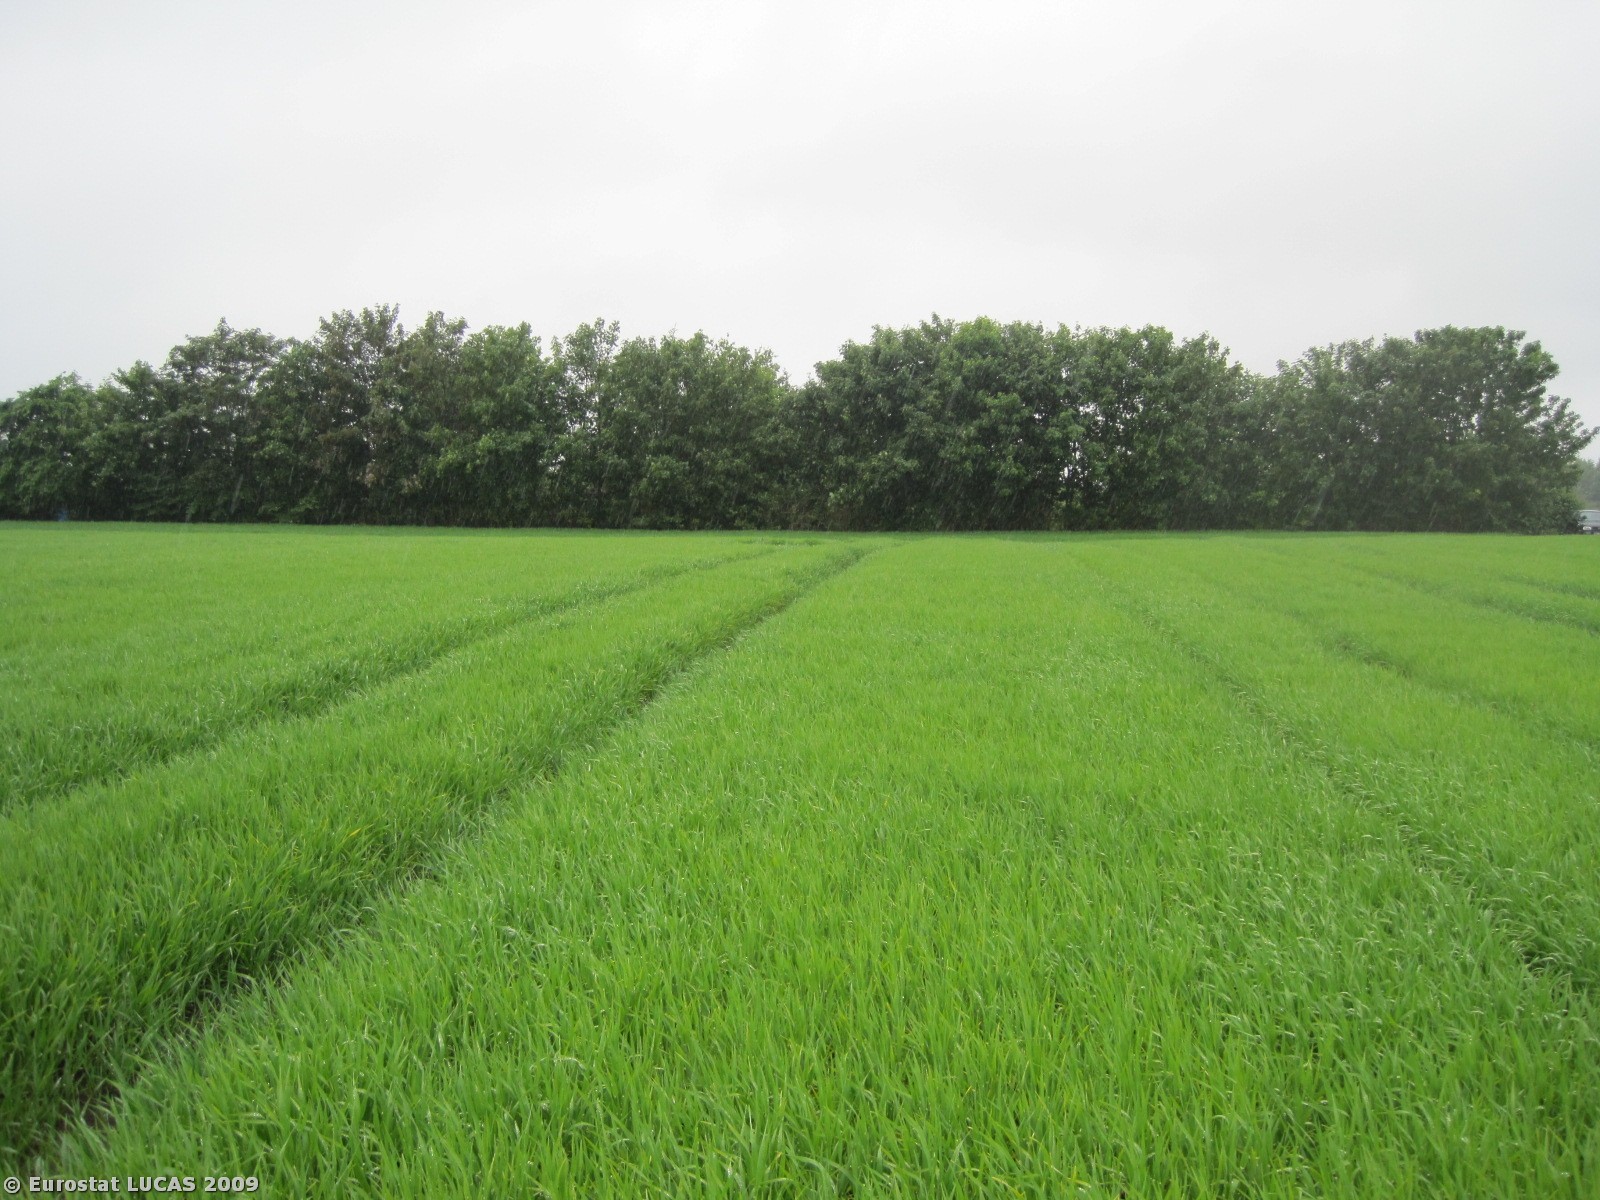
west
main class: Cropland
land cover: Barley
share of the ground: > 75 %
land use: Agriculture (excluding fallow land and kitchen gardens)
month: June
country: DK
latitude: 57.3563
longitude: 10.0830
